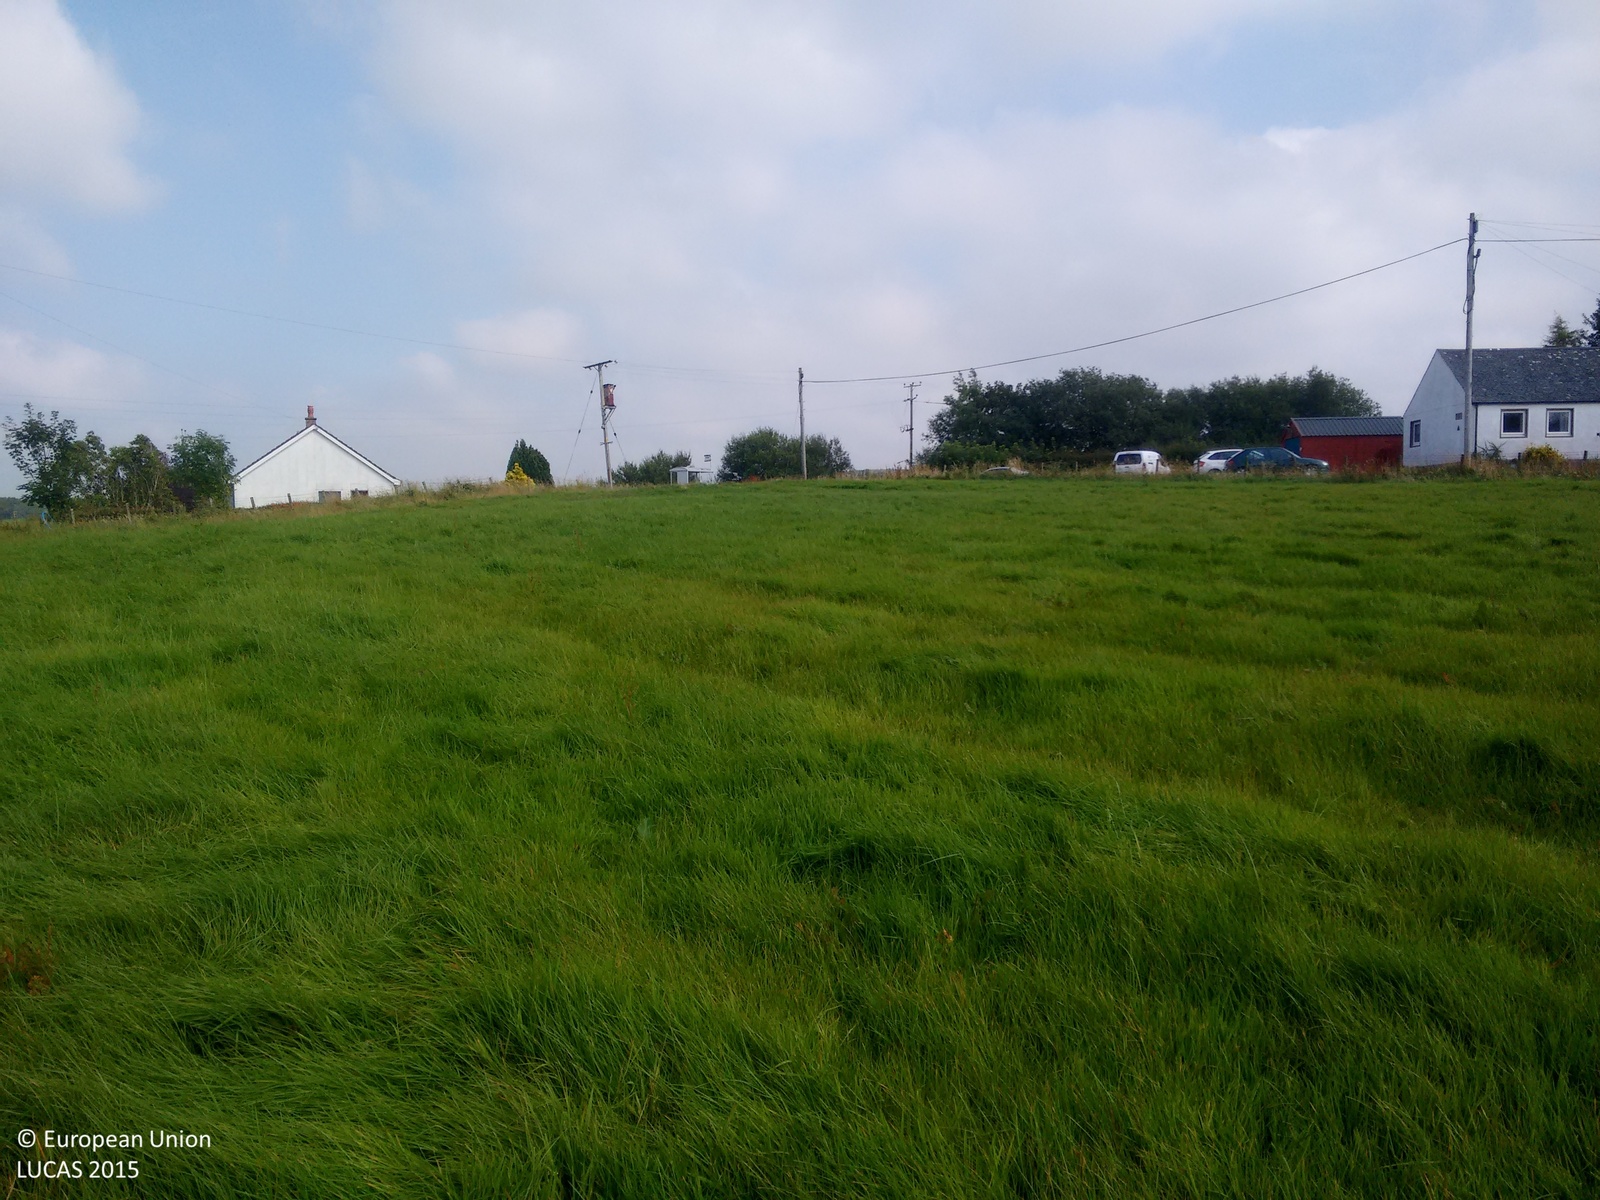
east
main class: Grassland
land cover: Grassland without tree/shrub cover
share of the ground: > 75 %
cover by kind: herbaceous plants 100 %
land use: Agriculture (excluding fallow land and kitchen gardens)
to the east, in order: Grassland without tree/shrub cover; Artificial constructions in urban areas; Broadleaved woodland; Grassland without tree/shrub cover; Artificial constructions in urban areas; Grassland without tree/shrub cover
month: September
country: GB
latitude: 55.0814
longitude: -4.9786
